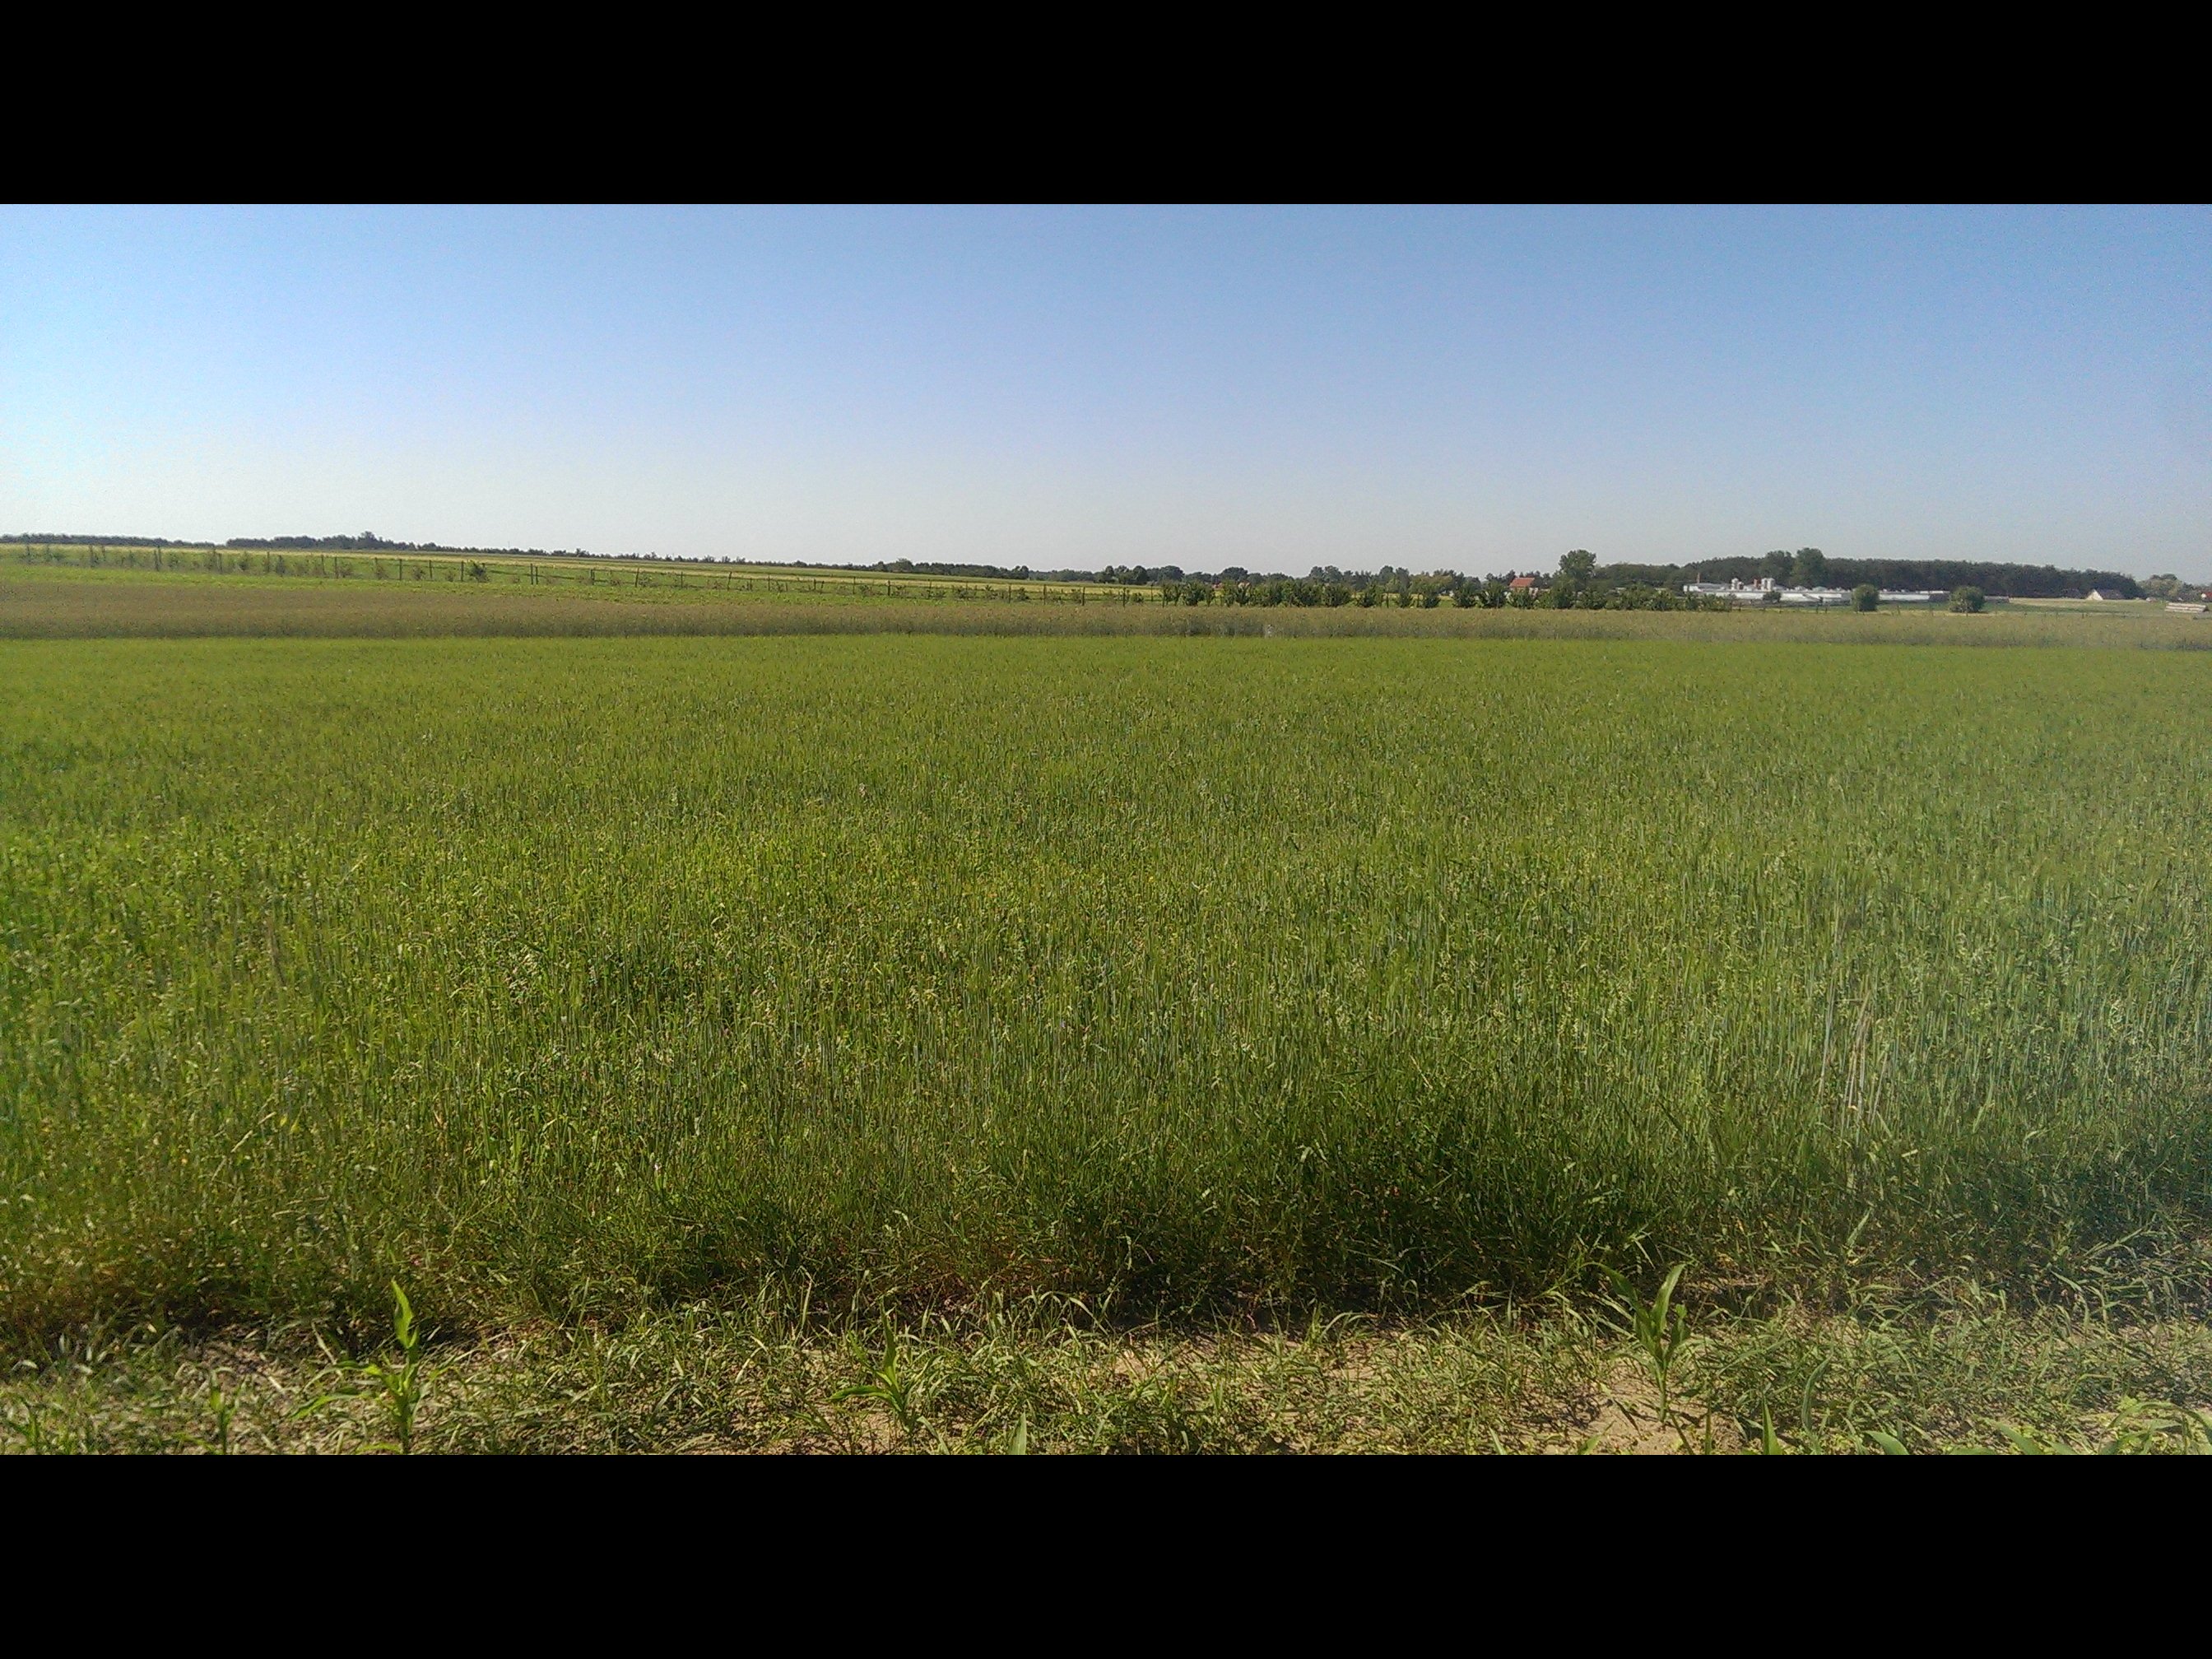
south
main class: Cropland
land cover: Maize
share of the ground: 10 - 25 %
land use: Agriculture (excluding fallow land and kitchen gardens)
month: June
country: PL
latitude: 51.9619
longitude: 16.2209
